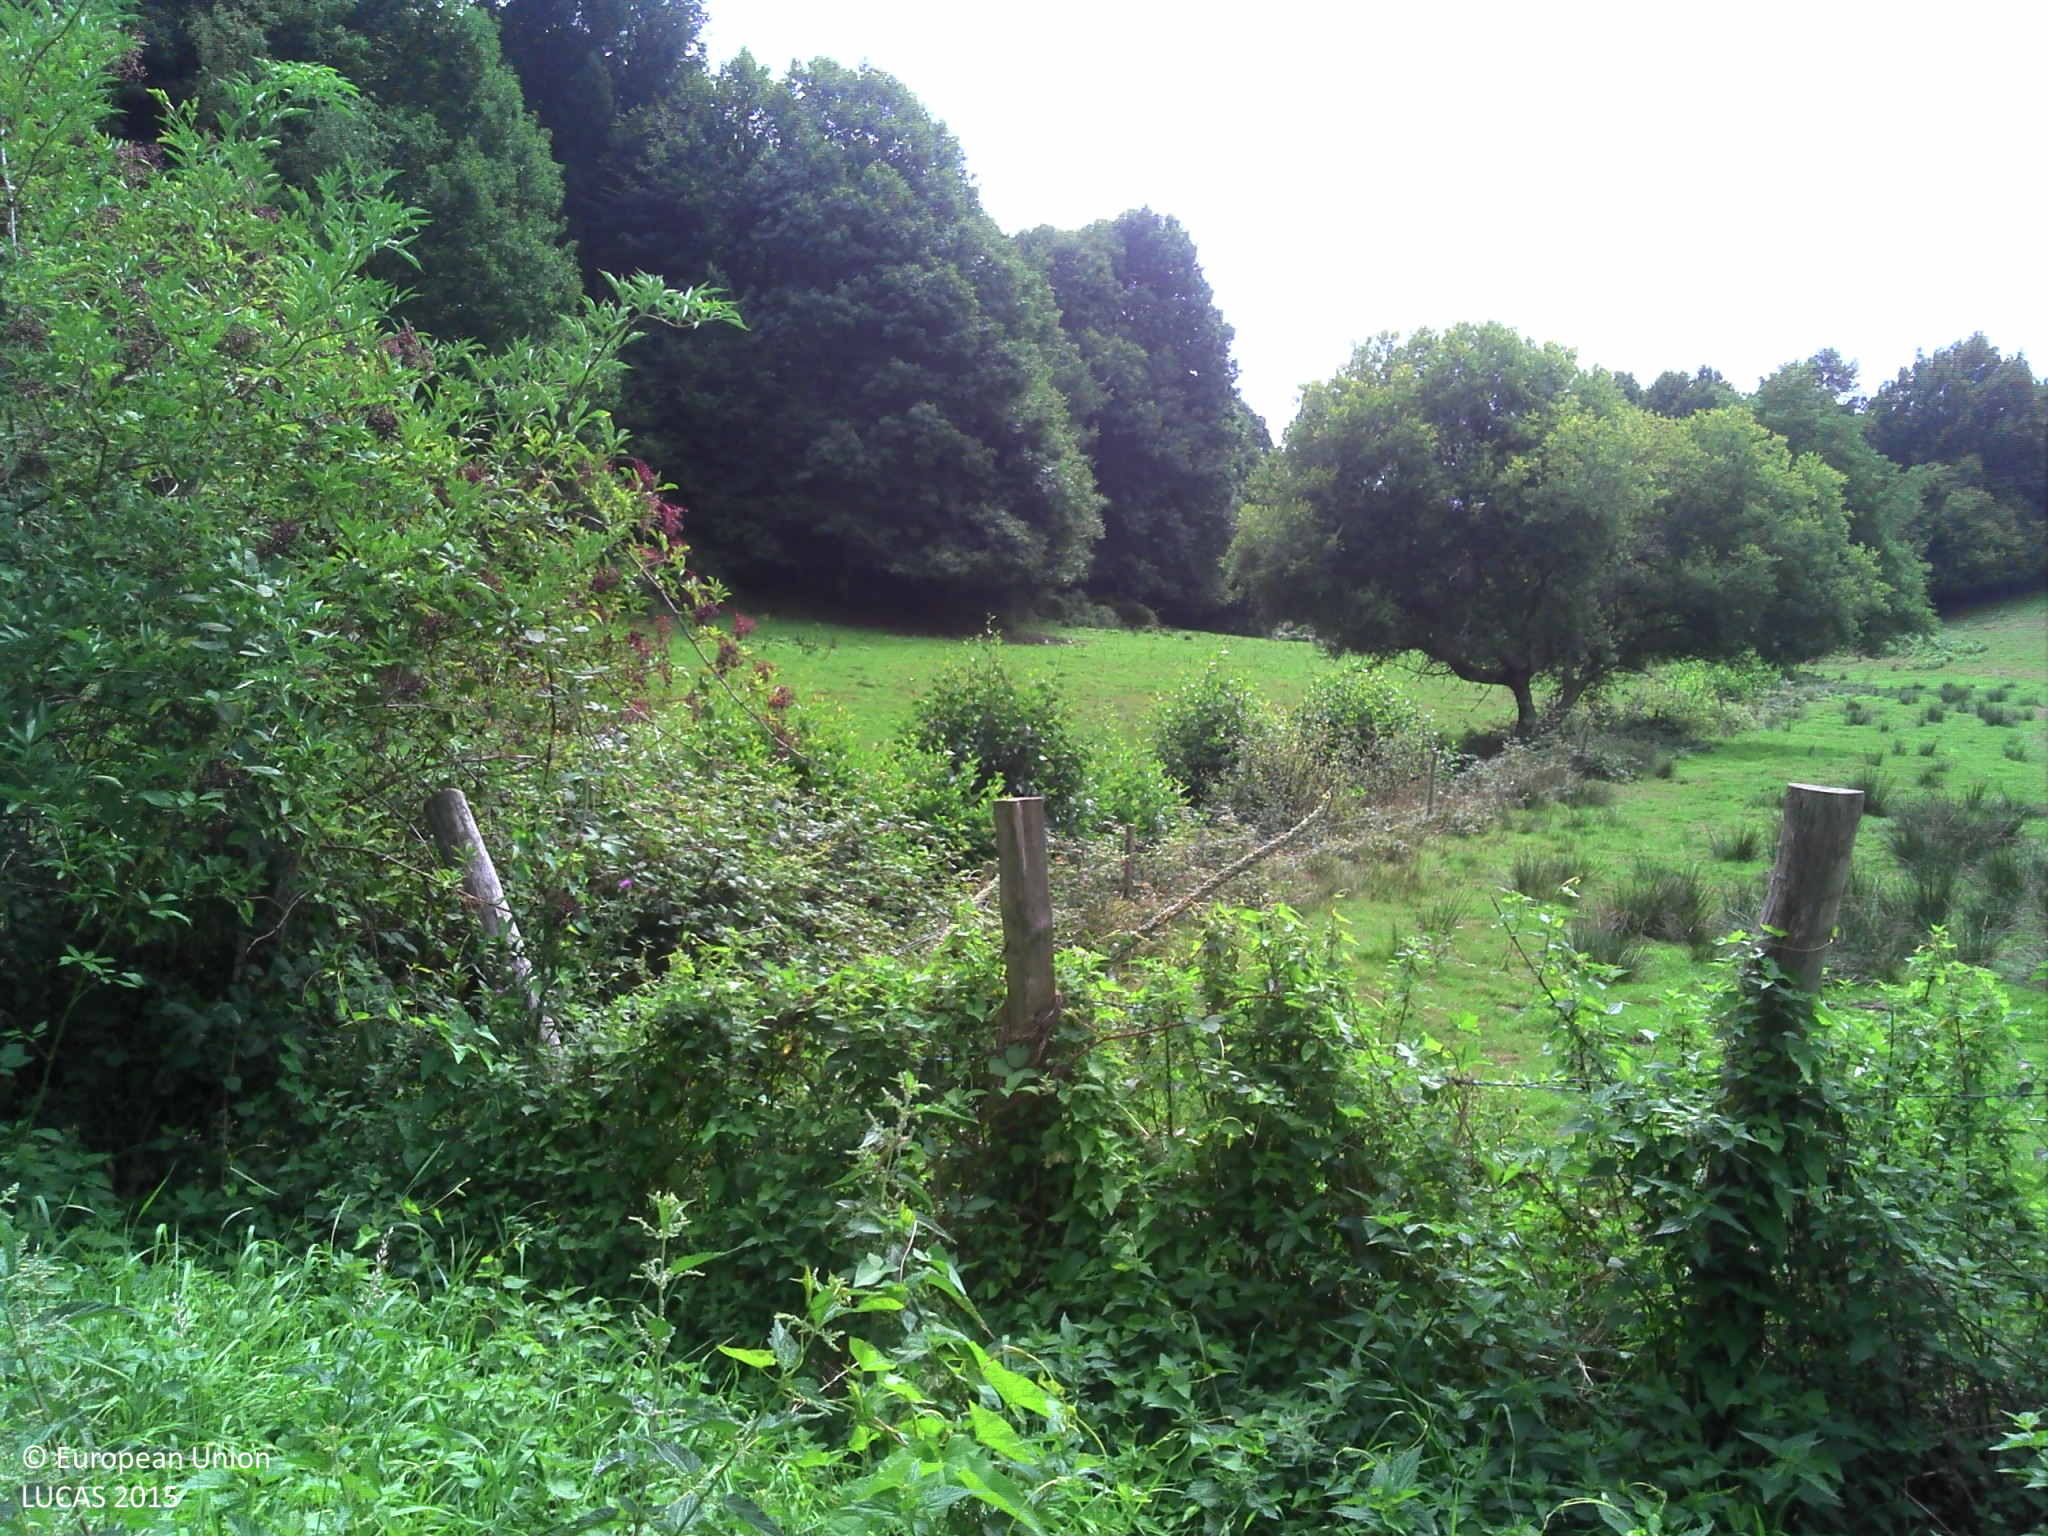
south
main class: Grassland
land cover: Grassland without tree/shrub cover
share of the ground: > 75 %
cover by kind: herbaceous plants 100 %
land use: Agriculture (excluding fallow land and kitchen gardens)
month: August
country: FR
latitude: 45.9605
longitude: 1.3067
